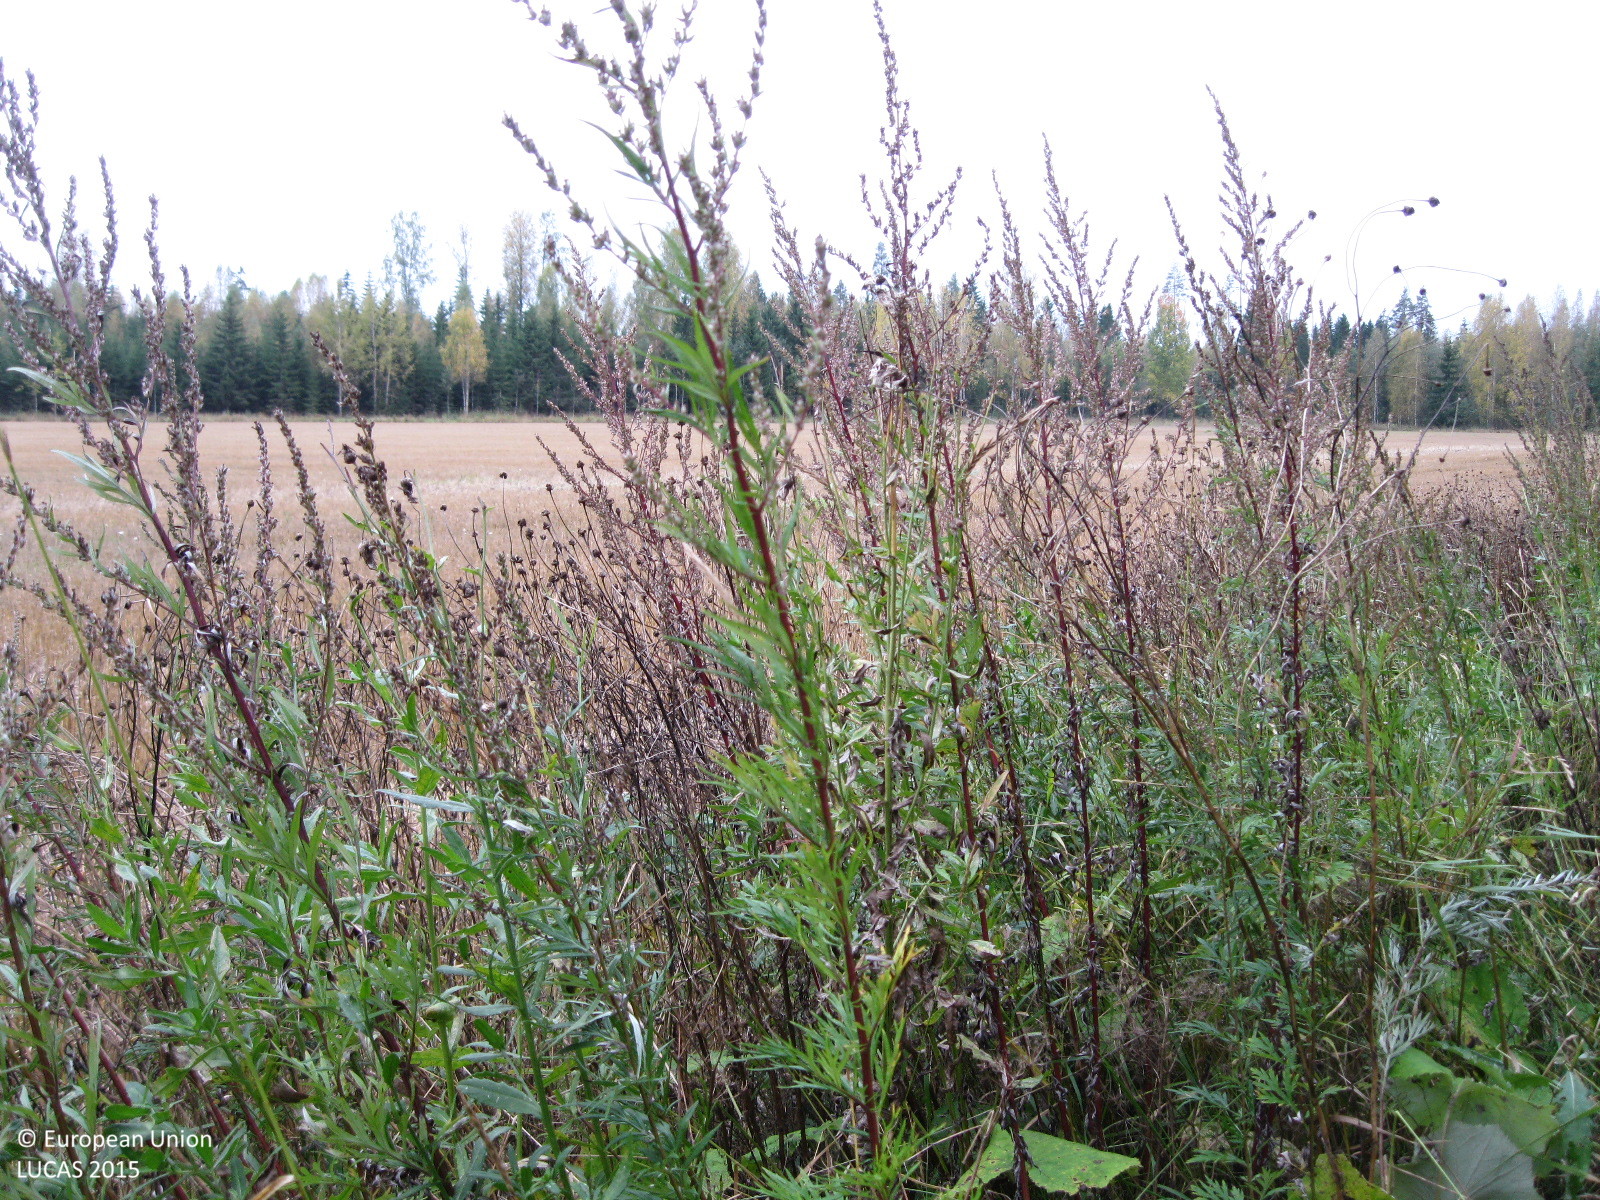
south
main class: Woodland
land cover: Broadleaved woodland
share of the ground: > 75 %
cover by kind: broadleaved forest trees 100 %
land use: Semi-natural and natural areas not in use
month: September
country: FI
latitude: 60.5981
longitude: 24.7002
